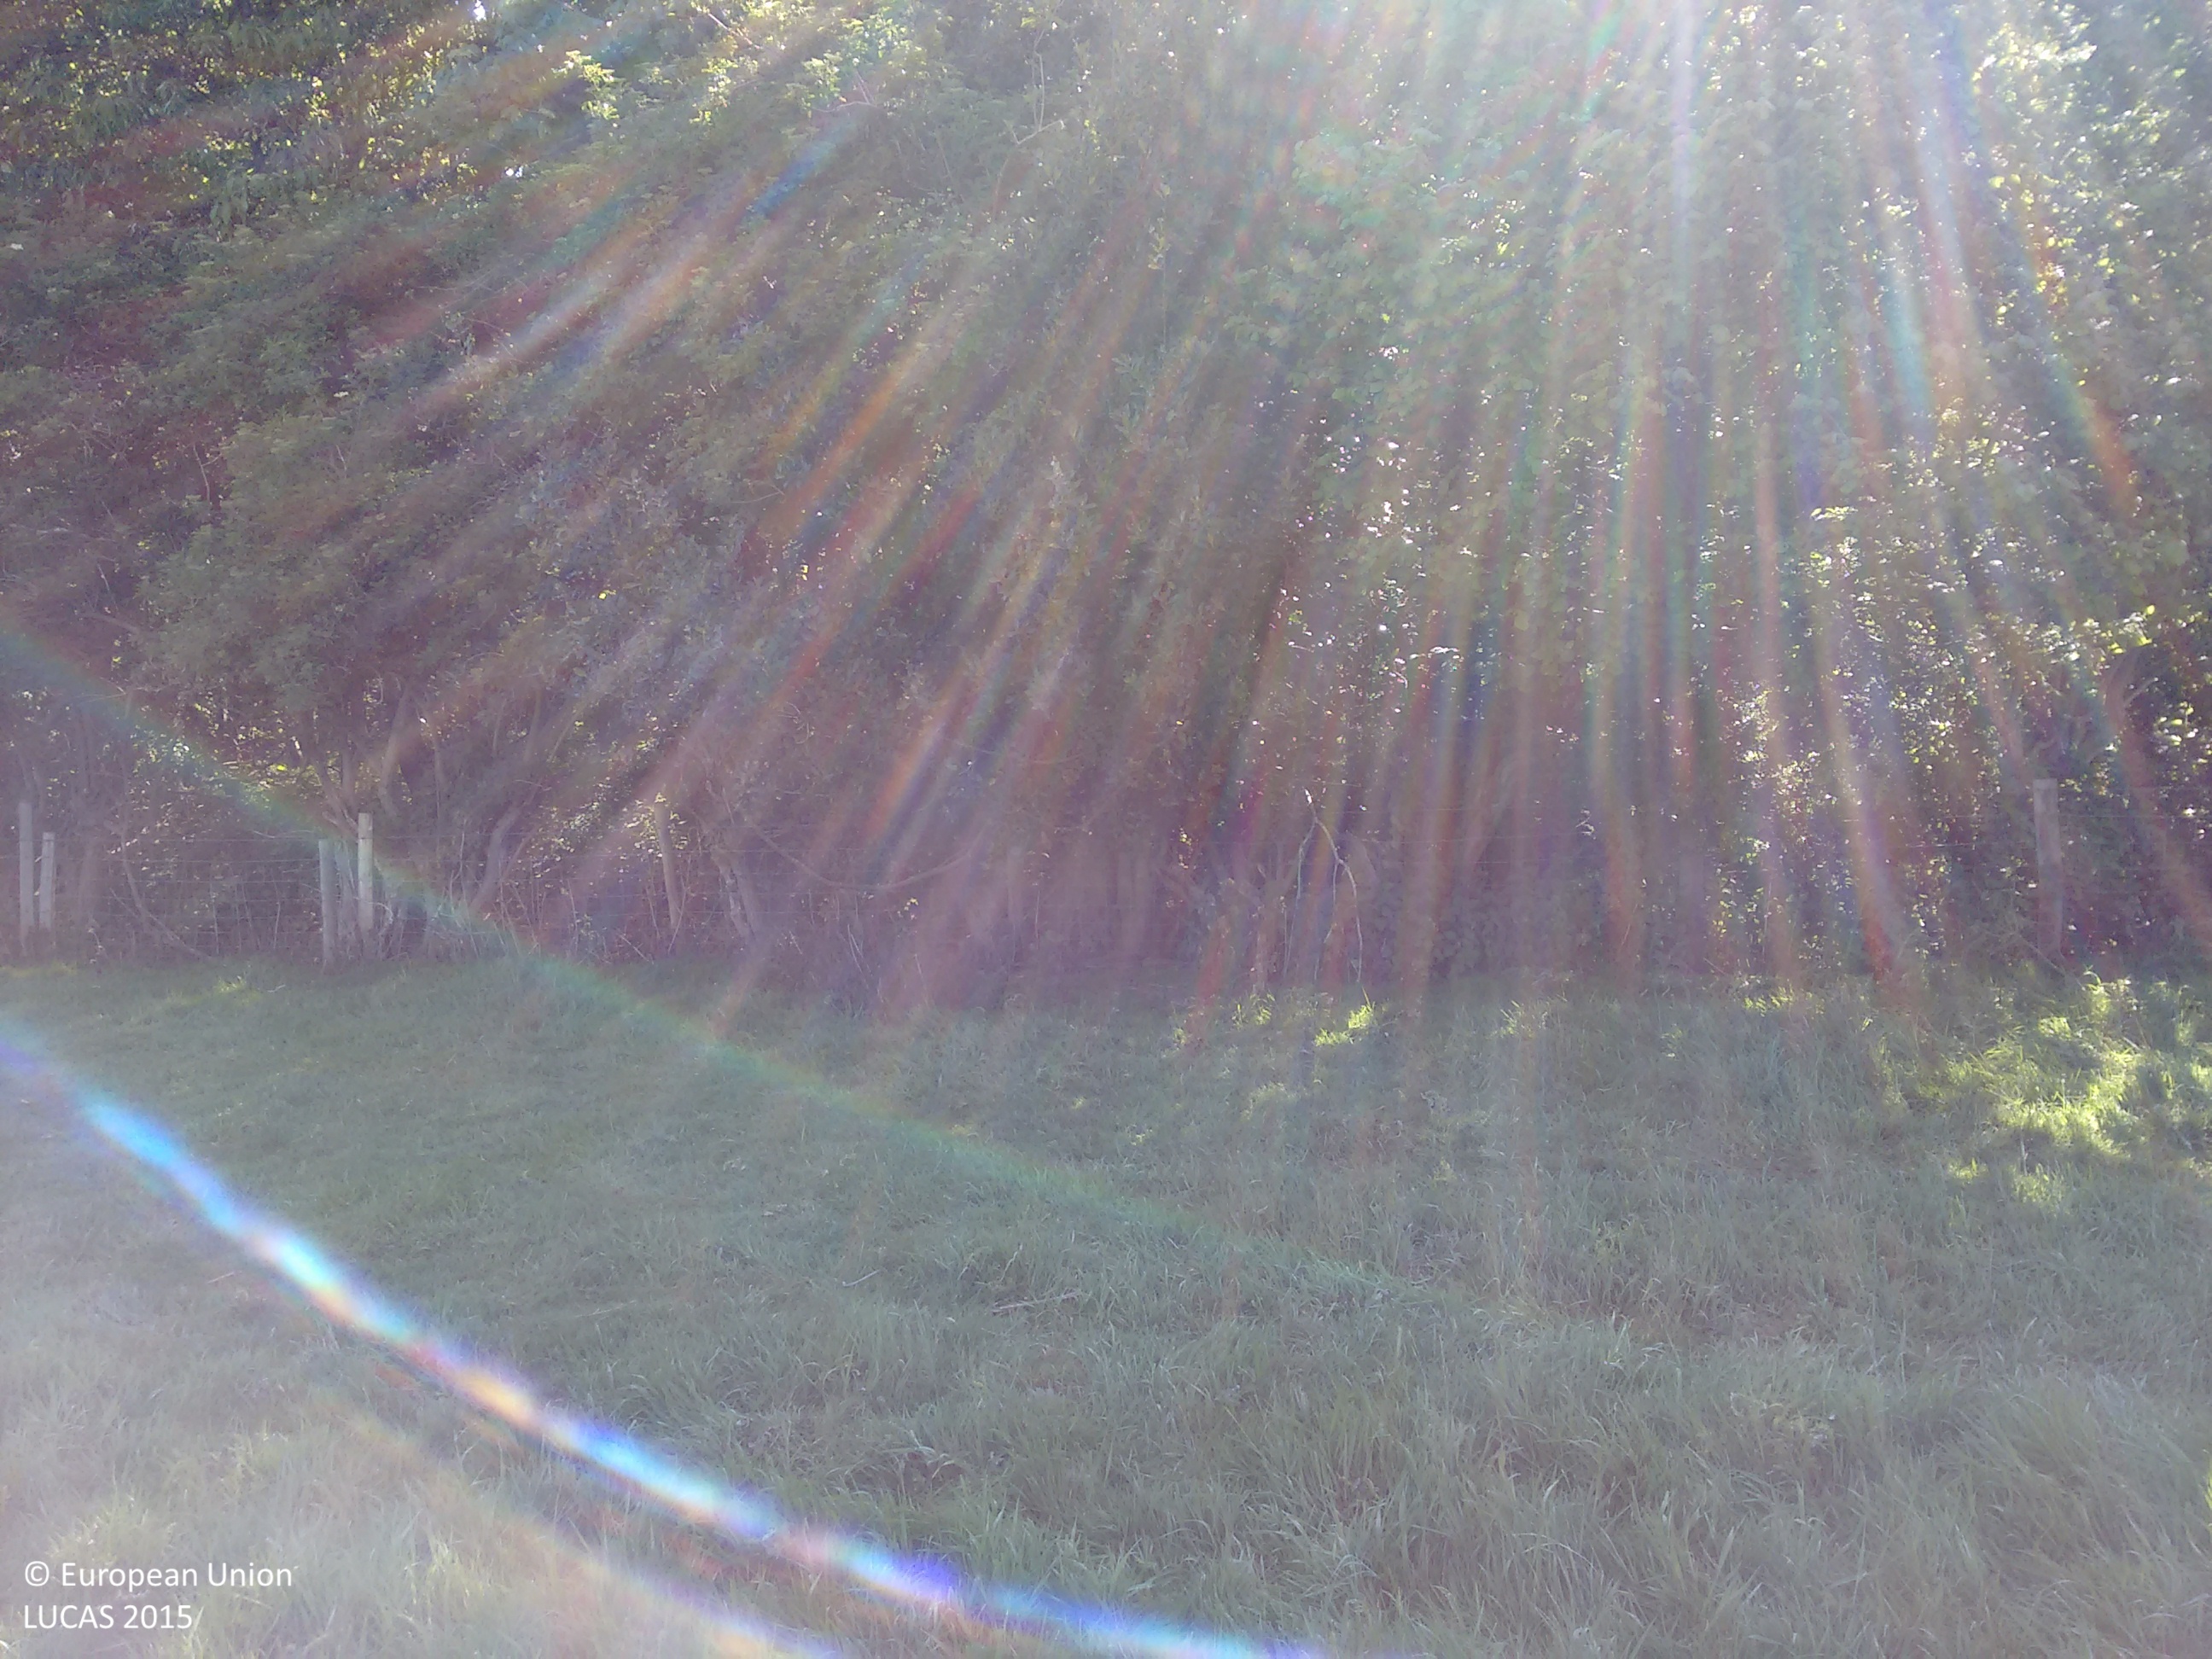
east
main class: Grassland
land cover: Grassland without tree/shrub cover
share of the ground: > 75 %
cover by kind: herbaceous plants 100 %
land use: Agriculture (excluding fallow land and kitchen gardens)
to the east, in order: Grassland without tree/shrub cover; Fences; Broadleaved woodland; Grassland with sparse tree/shrub cover; Broadleaved woodland; Ditches and canals; Fences; Grassland without tree/shrub cover
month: June
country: GB
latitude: 54.1893
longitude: -1.1862
